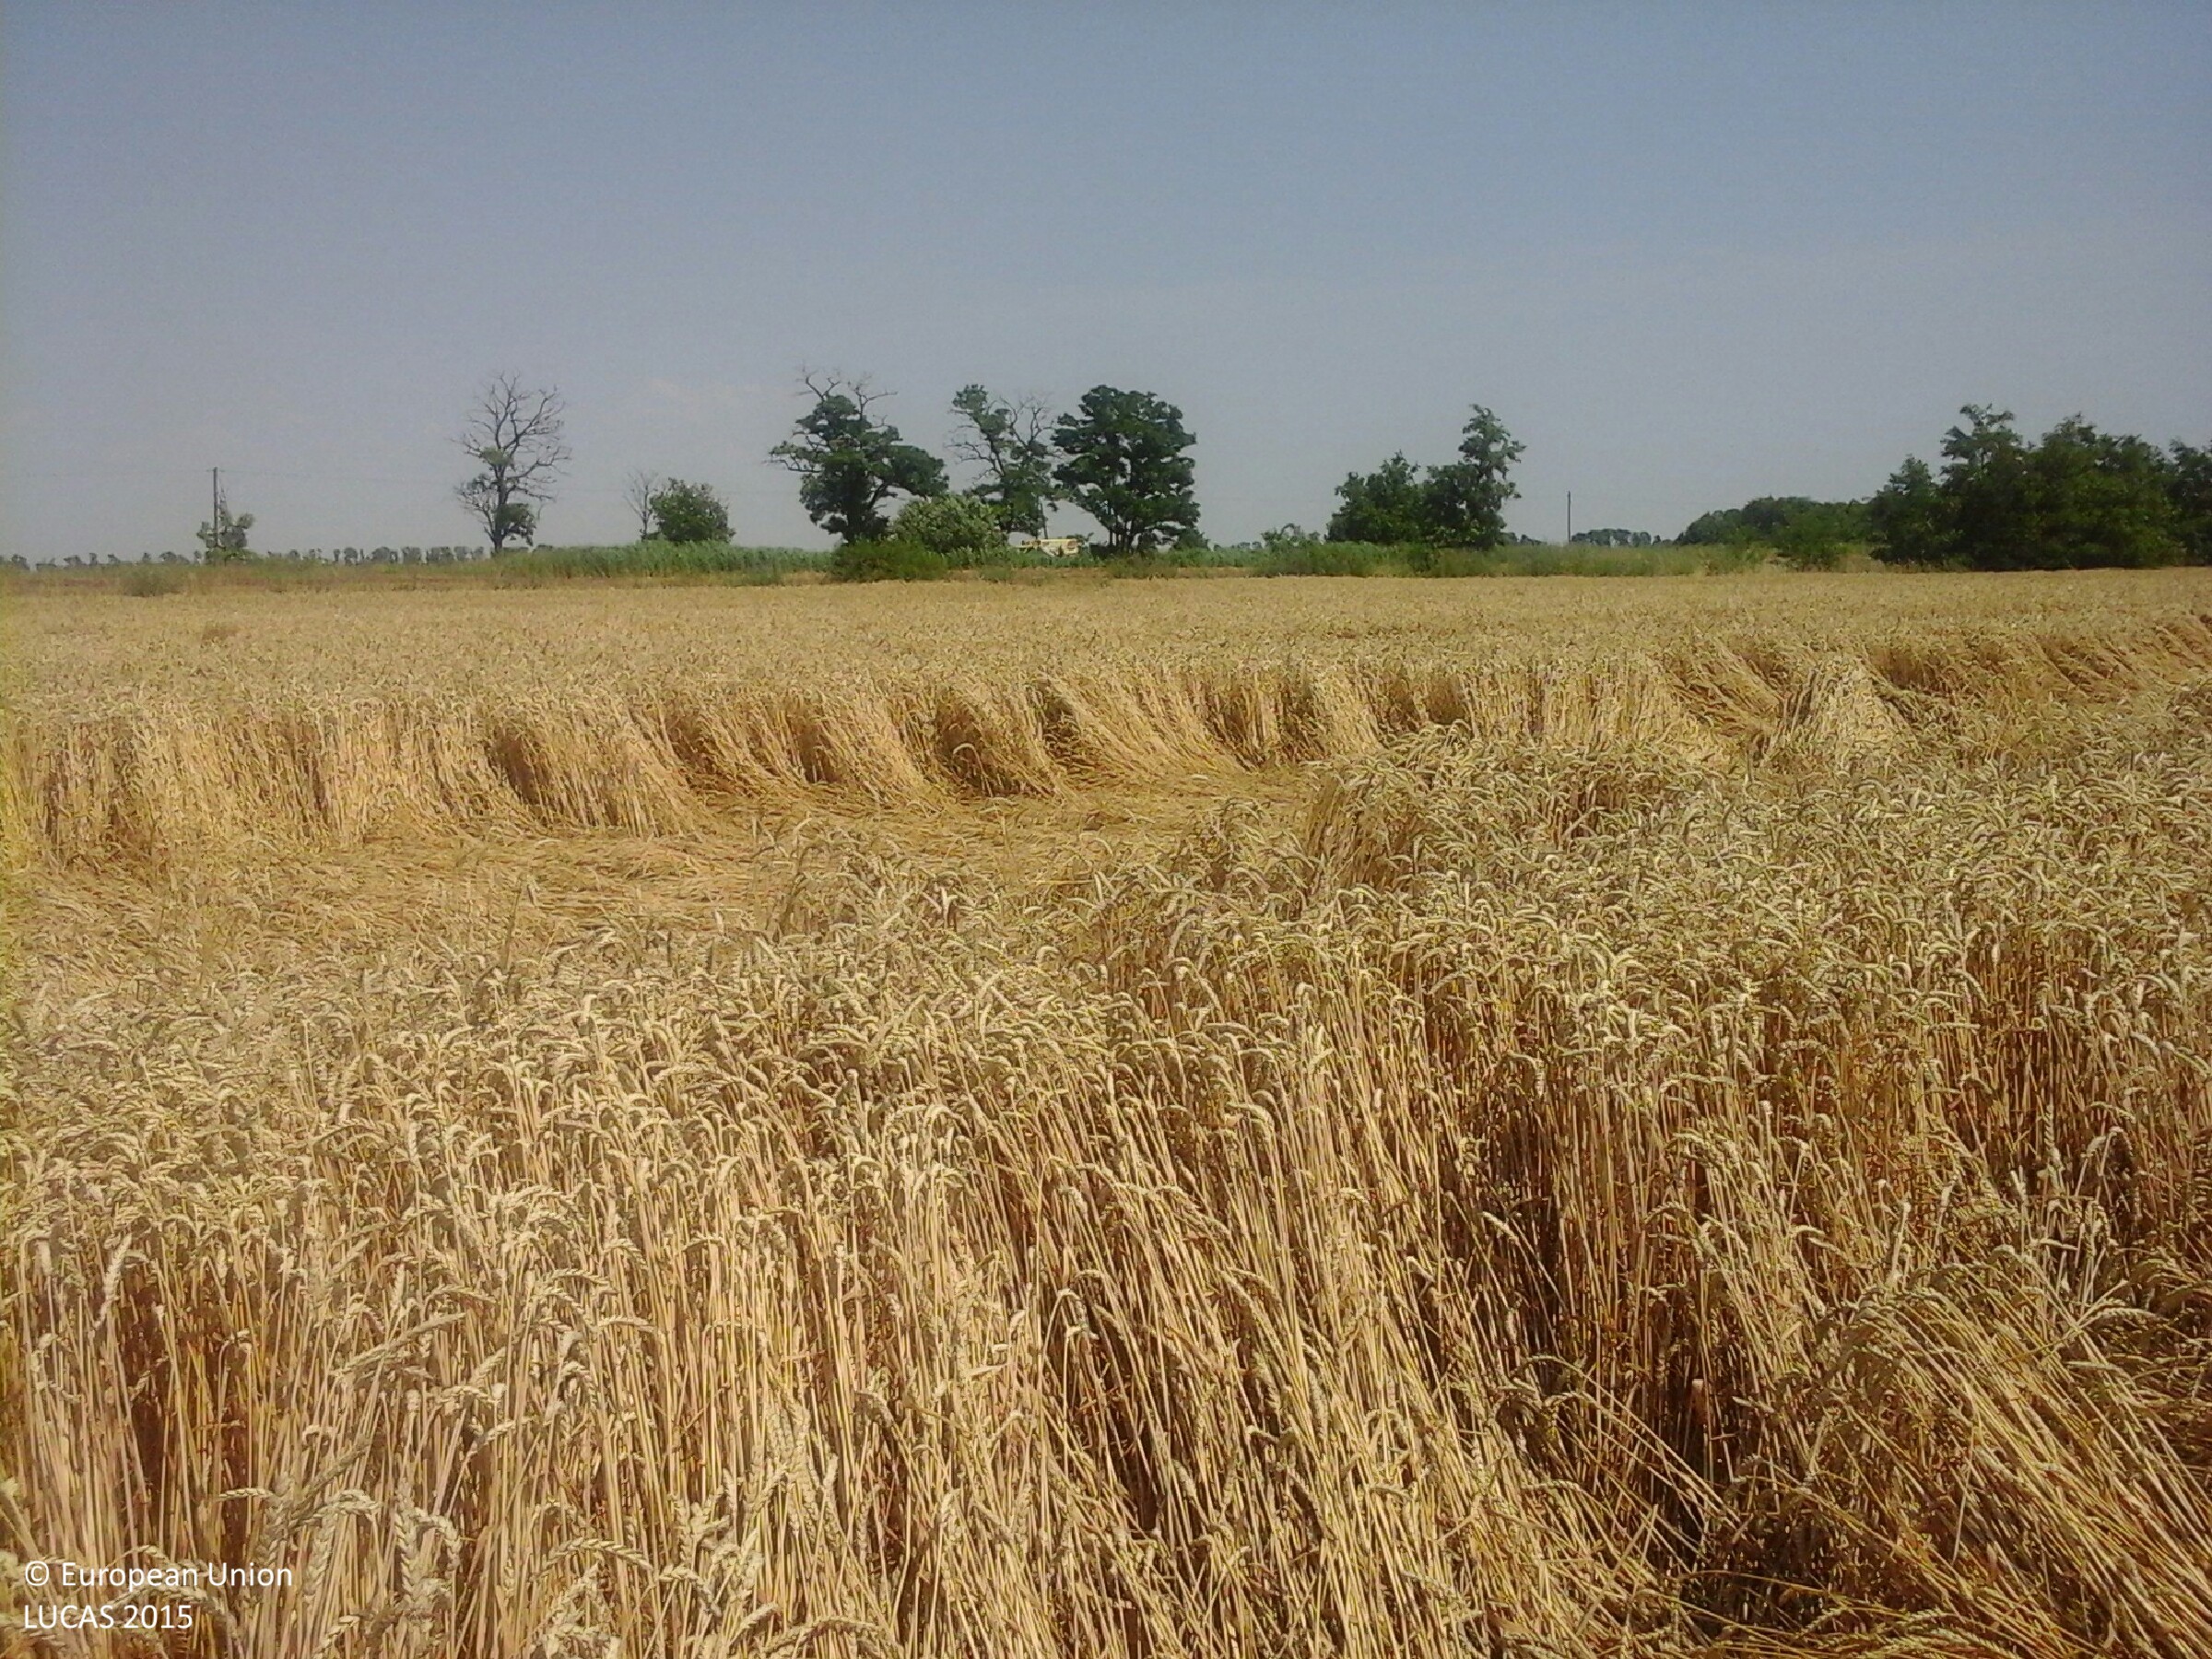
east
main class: Cropland
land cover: Common wheat
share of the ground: > 75 %
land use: Agriculture (excluding fallow land and kitchen gardens)
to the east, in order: Common wheat; Ditches and canals; Grass margins; Tracks; Grassland without tree/shrub cover; Inland fresh running water; Grassland without tree/shrub cover; Inland fresh running water; Grassland with sparse tree/shrub cover; Paved roads, cycling and walking lanes; Grassland with sparse tree/shrub cover; Electric lines; Rape and turnip rape
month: July
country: HU
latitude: 47.7566
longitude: 20.5042
